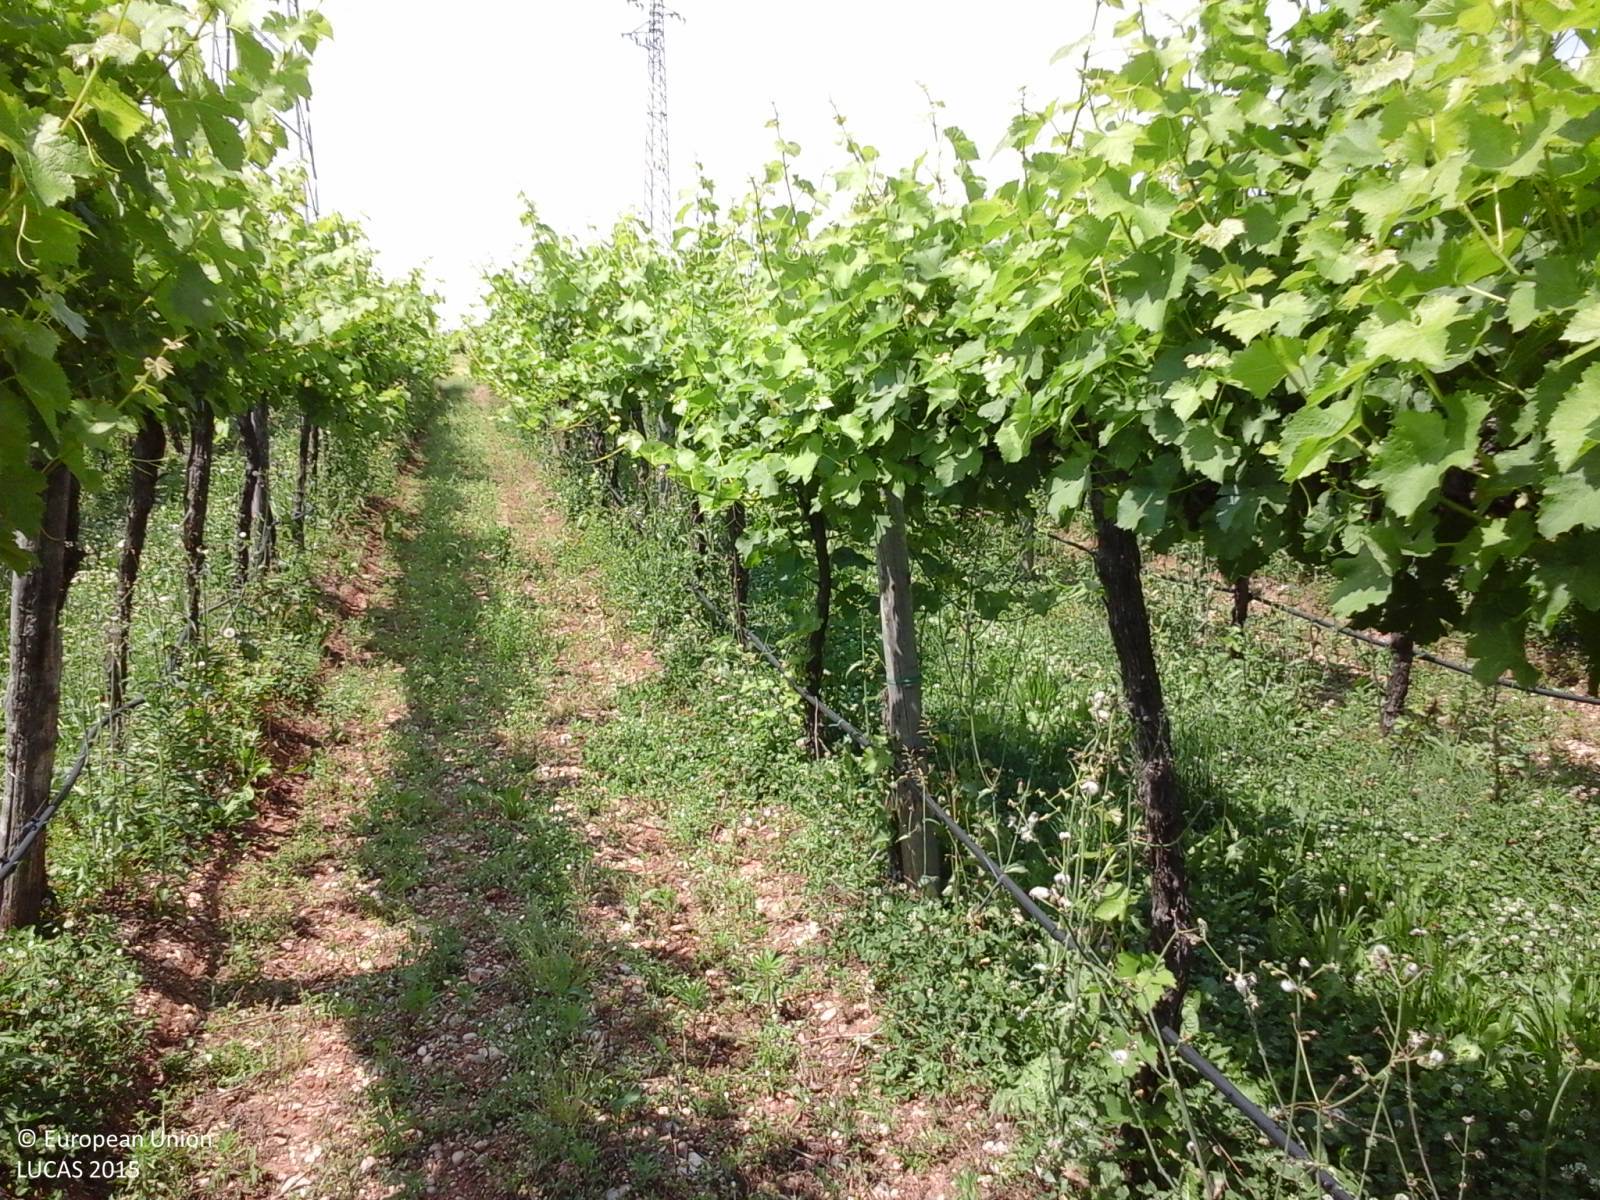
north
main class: Cropland
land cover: Vineyards
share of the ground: > 75 %
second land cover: Grassland without tree/shrub cover
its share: > 75 %
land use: Agriculture (excluding fallow land and kitchen gardens)
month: June
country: IT
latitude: 45.9370
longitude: 13.3883
